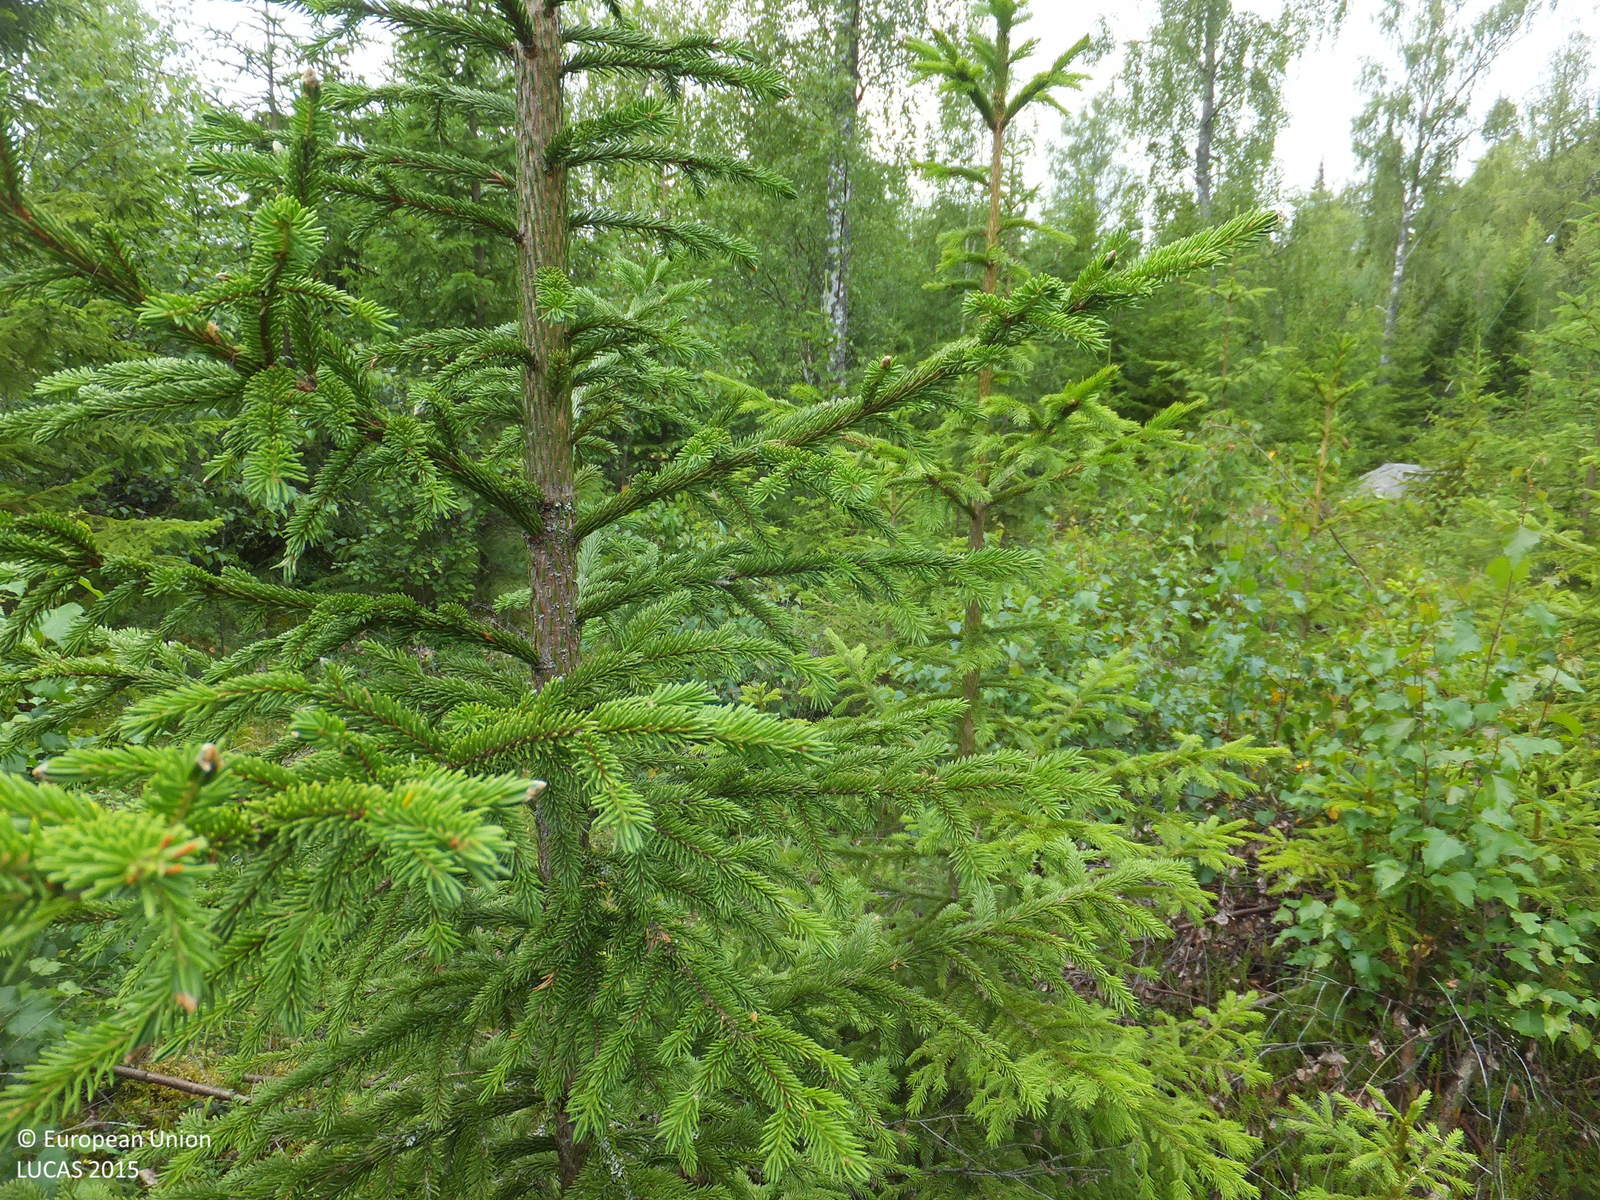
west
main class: Woodland
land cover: Spruce dominated mixed woodland
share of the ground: 25 - 50 %
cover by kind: shrubs 40 %, coniferous forest trees 15 %, broadleaved forest trees 15 %, herbaceous plants 10 %, lichens and mosses 10 %, consolidated bare surface 10 %
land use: Forestry
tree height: < 5 m
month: July
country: FI
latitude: 63.2954
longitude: 21.1029
